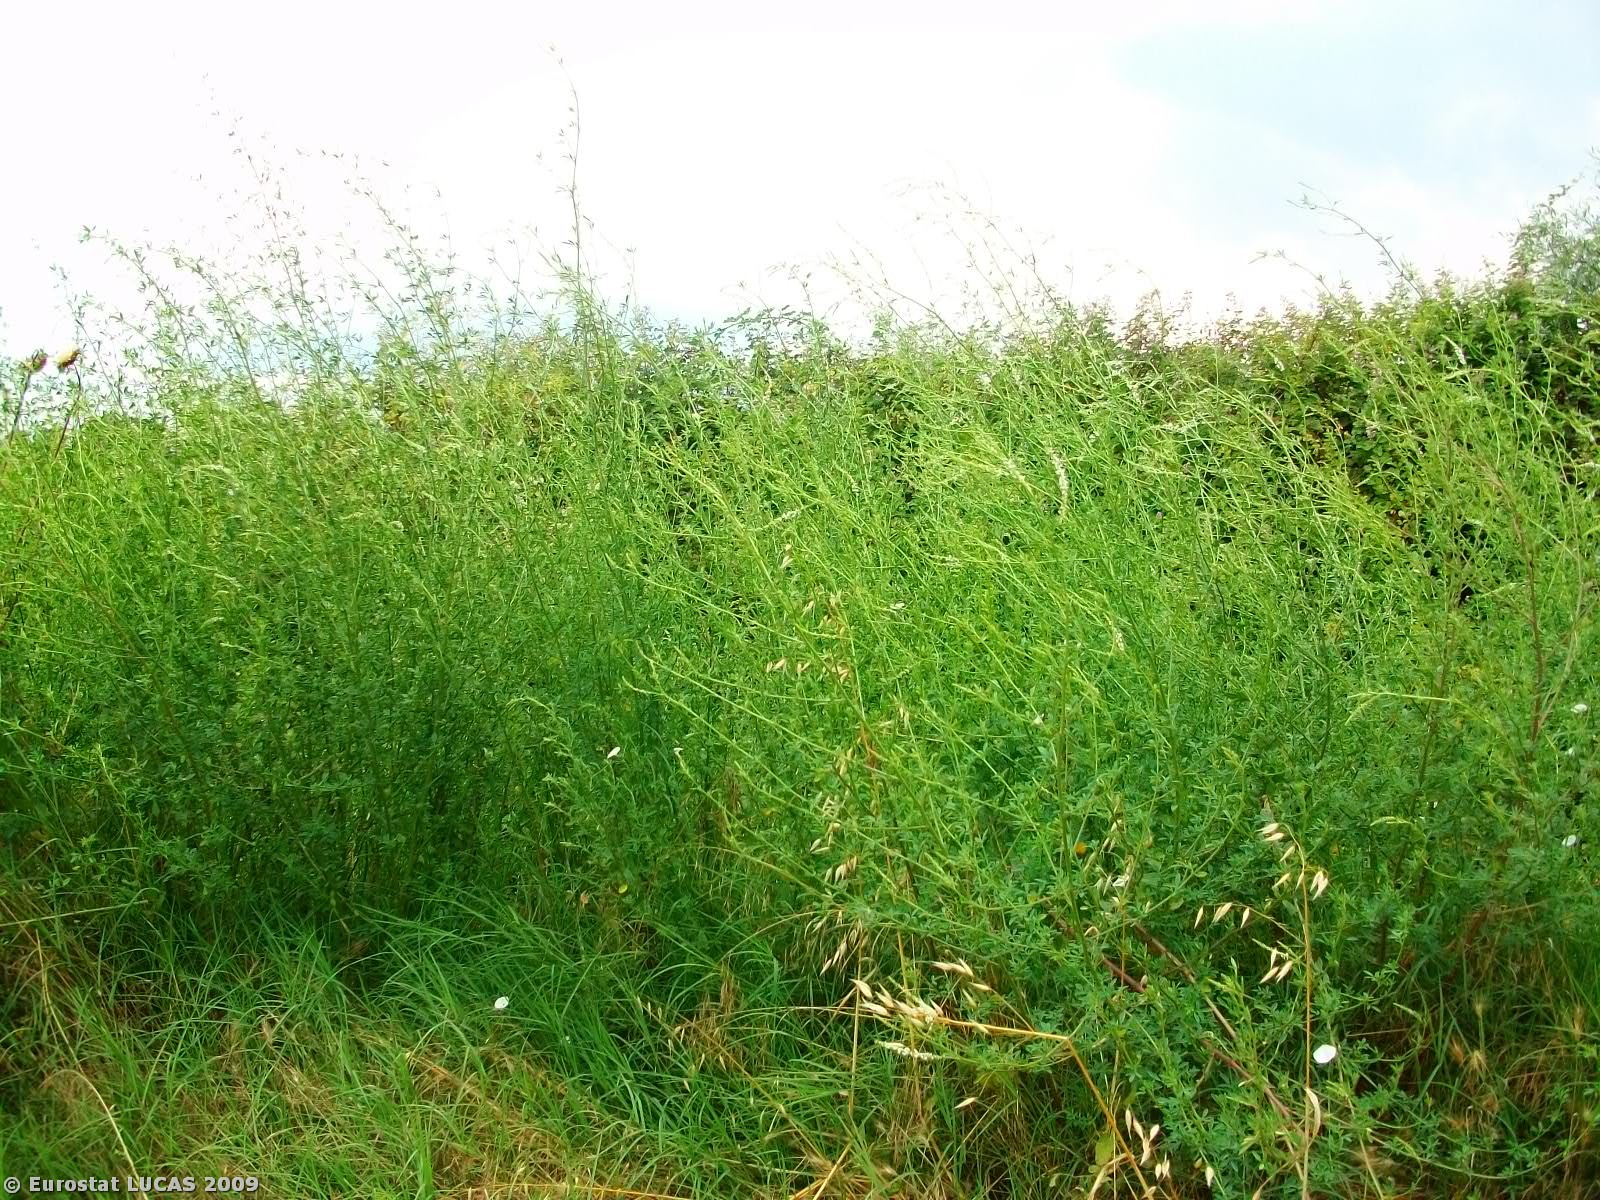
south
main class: Cropland
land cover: Durum wheat
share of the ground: > 75 %
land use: Agriculture (excluding fallow land and kitchen gardens)
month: June
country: GR
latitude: 40.9957
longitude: 23.6315
